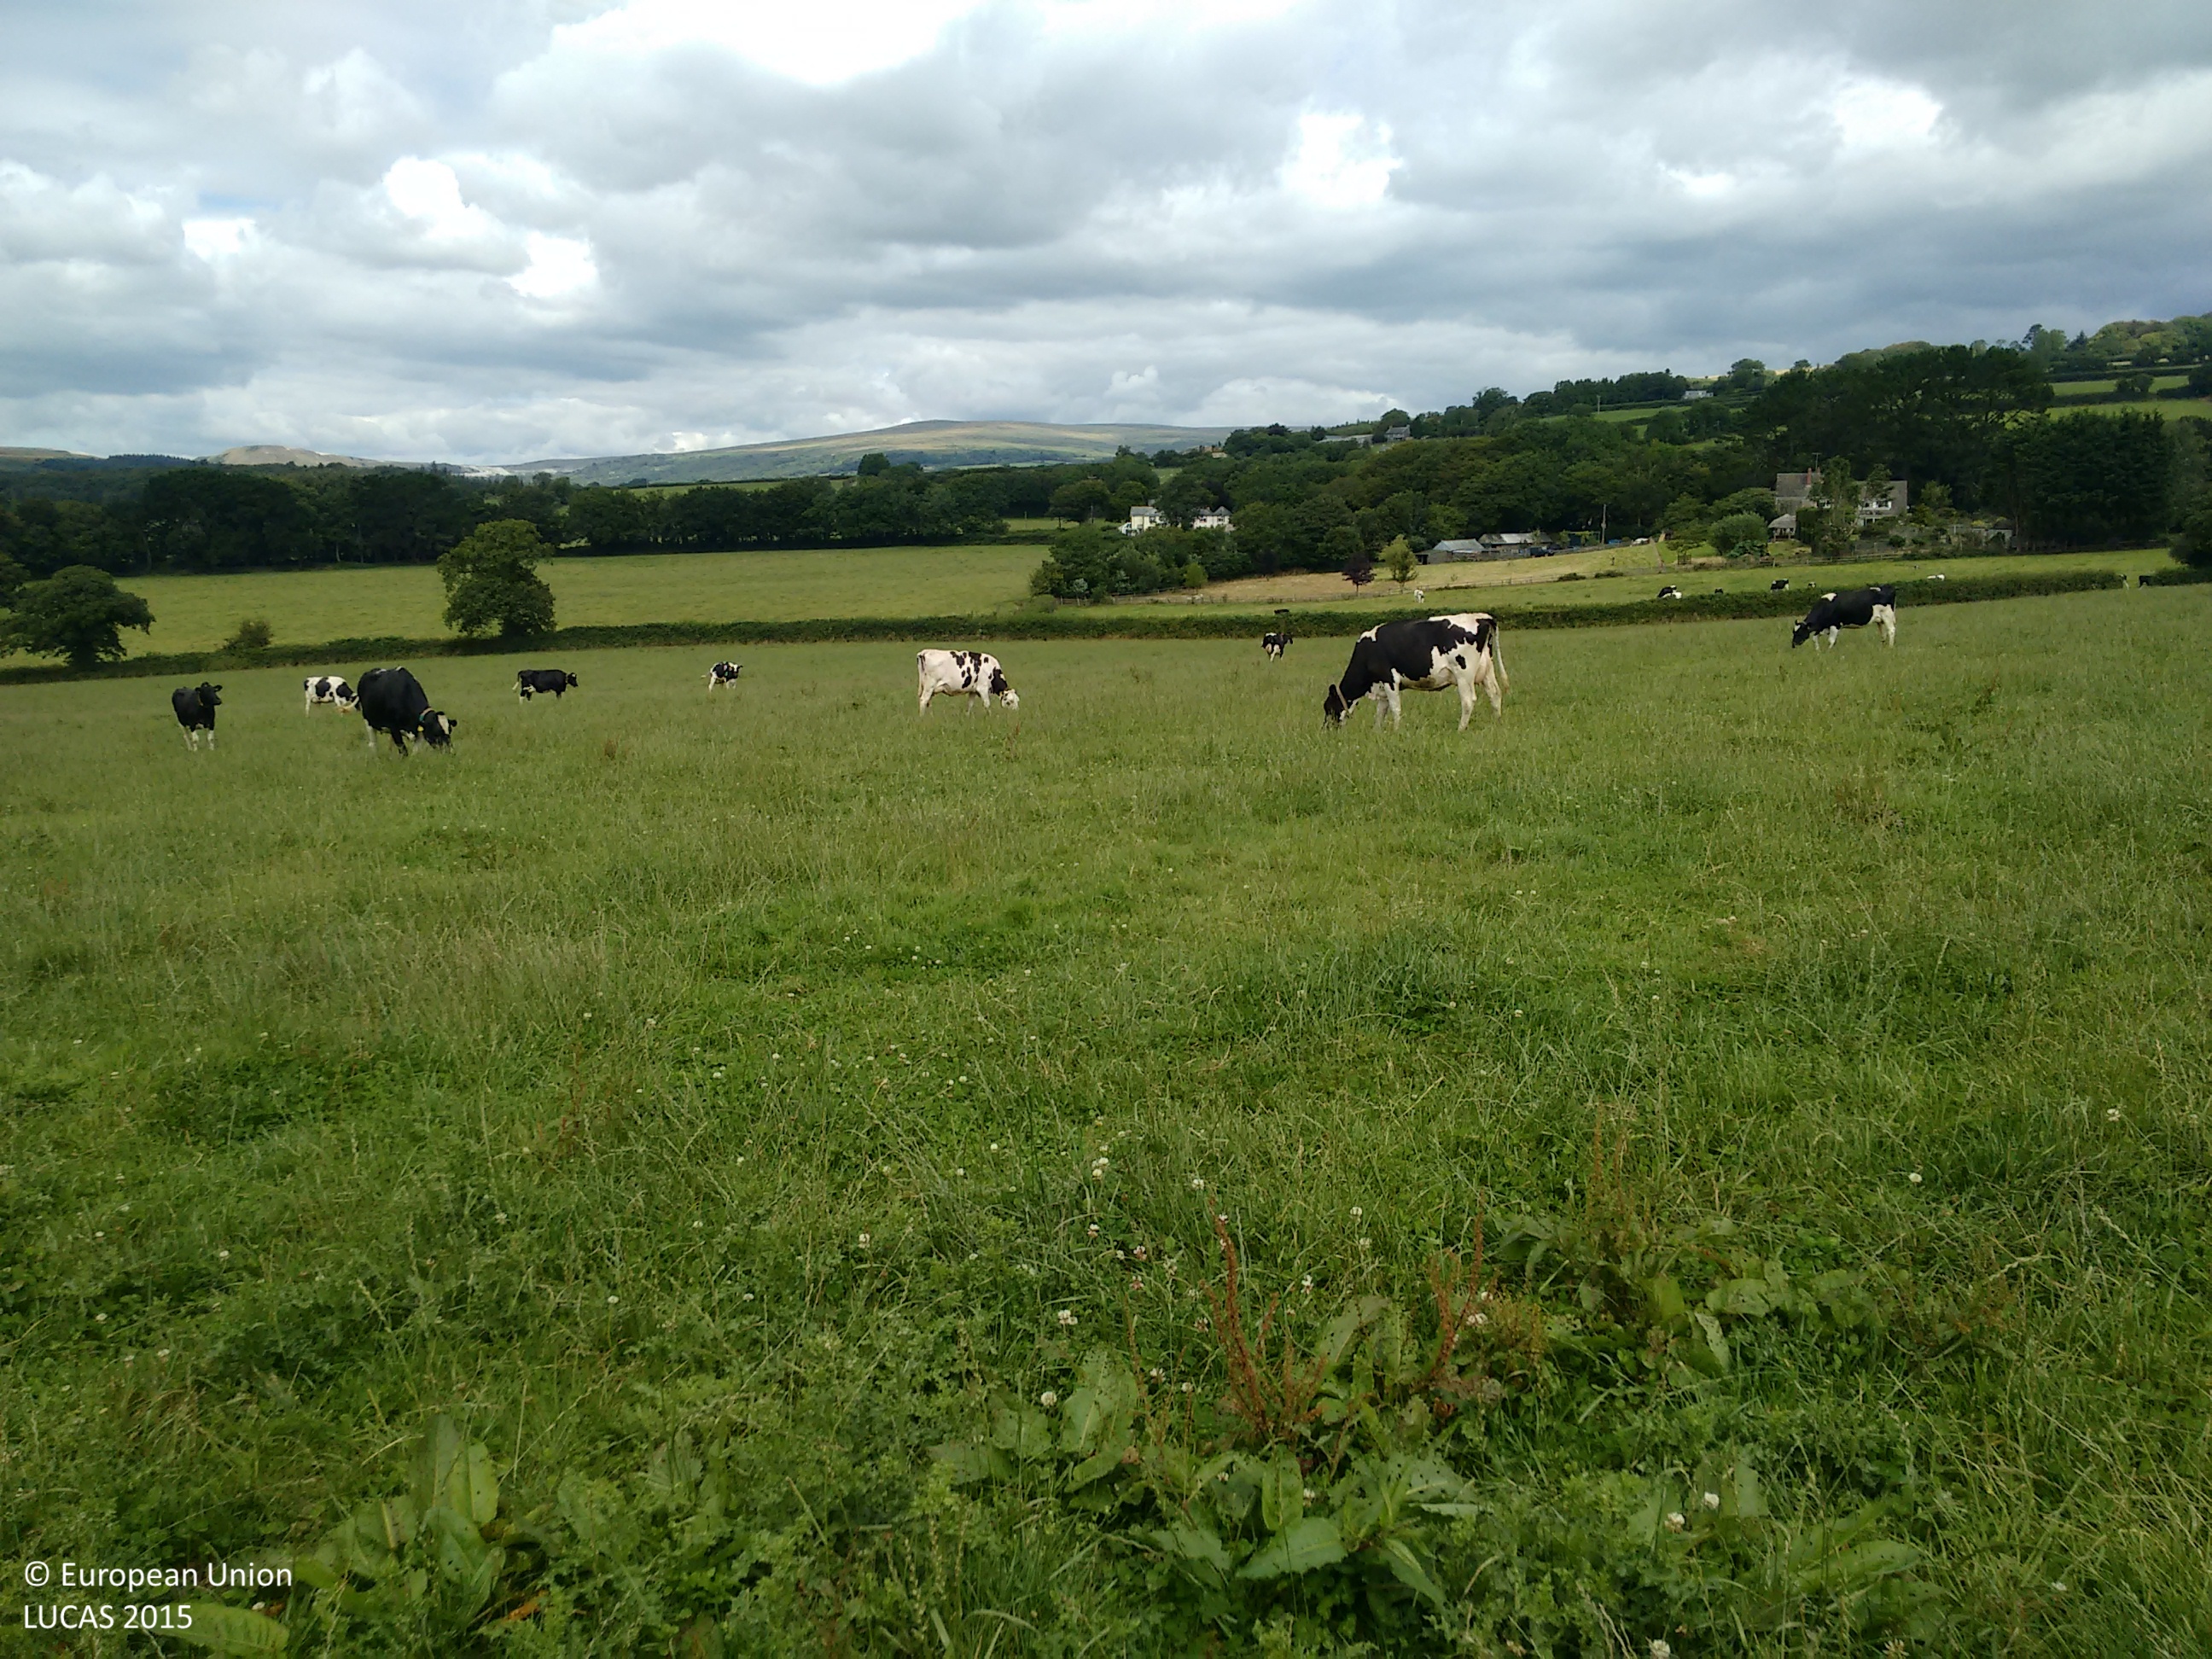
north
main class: Grassland
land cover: Grassland without tree/shrub cover
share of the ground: > 75 %
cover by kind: herbaceous plants 100 %
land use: Agriculture (excluding fallow land and kitchen gardens)
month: August
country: GB
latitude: 50.3983
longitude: -3.9495
